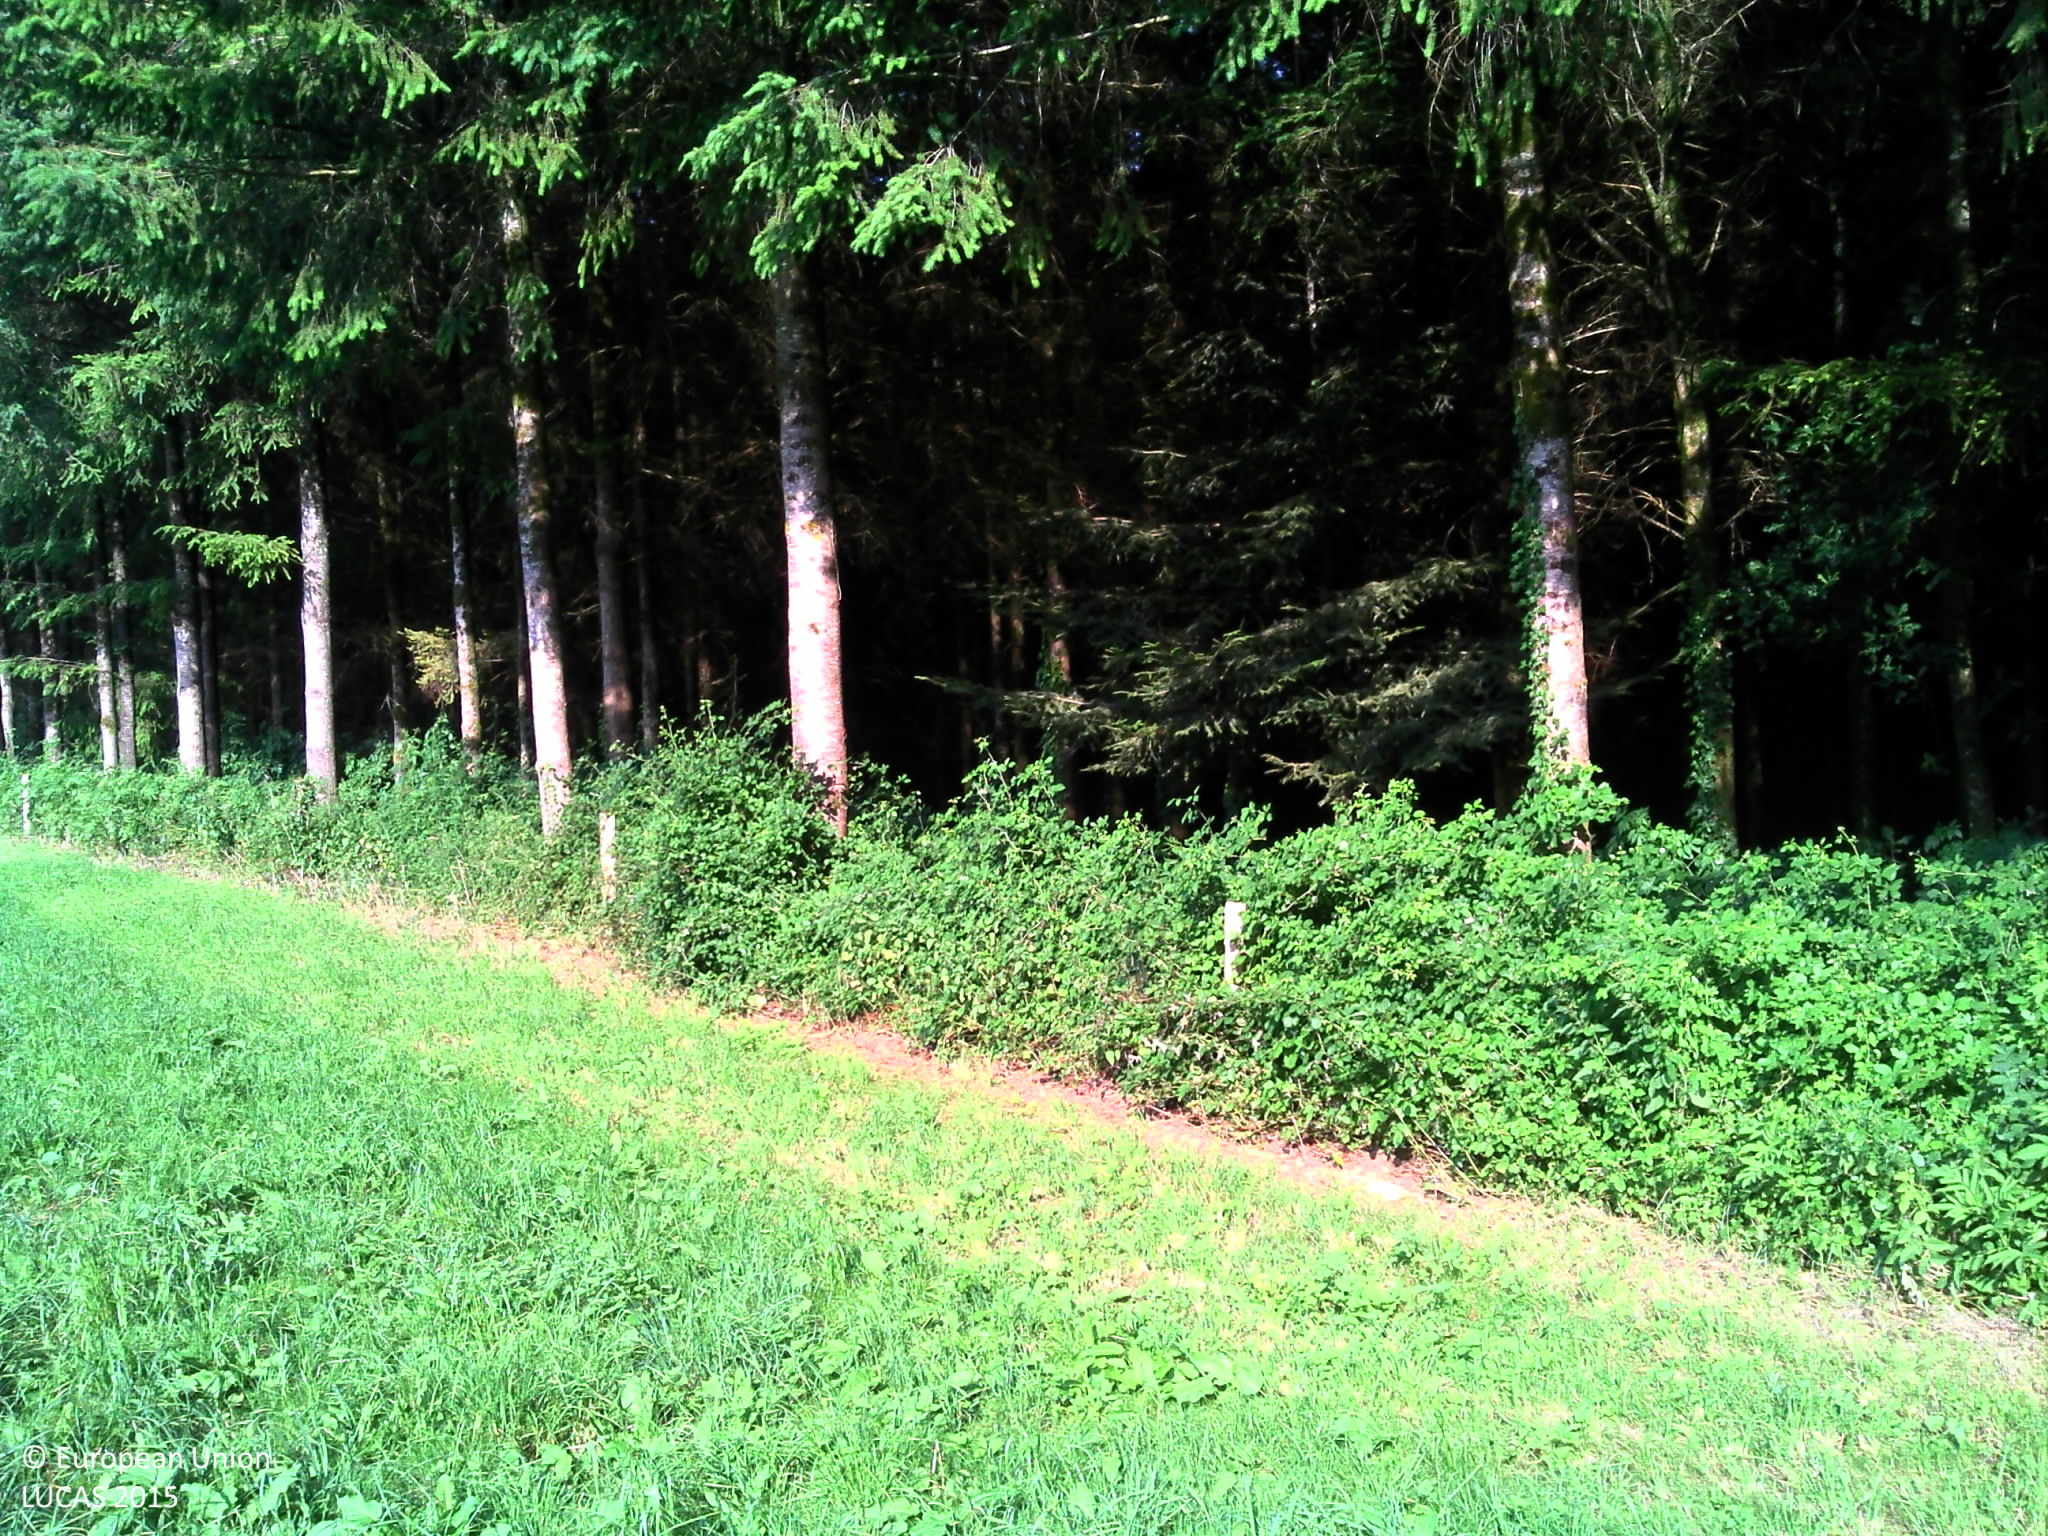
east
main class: Grassland
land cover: Grassland without tree/shrub cover
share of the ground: > 75 %
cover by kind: herbaceous plants 100 %
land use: Agriculture (excluding fallow land and kitchen gardens)
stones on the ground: < 10 %
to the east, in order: Grassland without tree/shrub cover; Pine dominated coniferous woodland; Ditches and canals; Pine dominated coniferous woodland; Fences; Triticale; Fences; Pine dominated coniferous woodland; Paved roads, cycling and walking lanes; Lines of trees; Fences; Grassland without tree/shrub cover
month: June
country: FR
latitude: 45.7207
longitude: 0.6207
